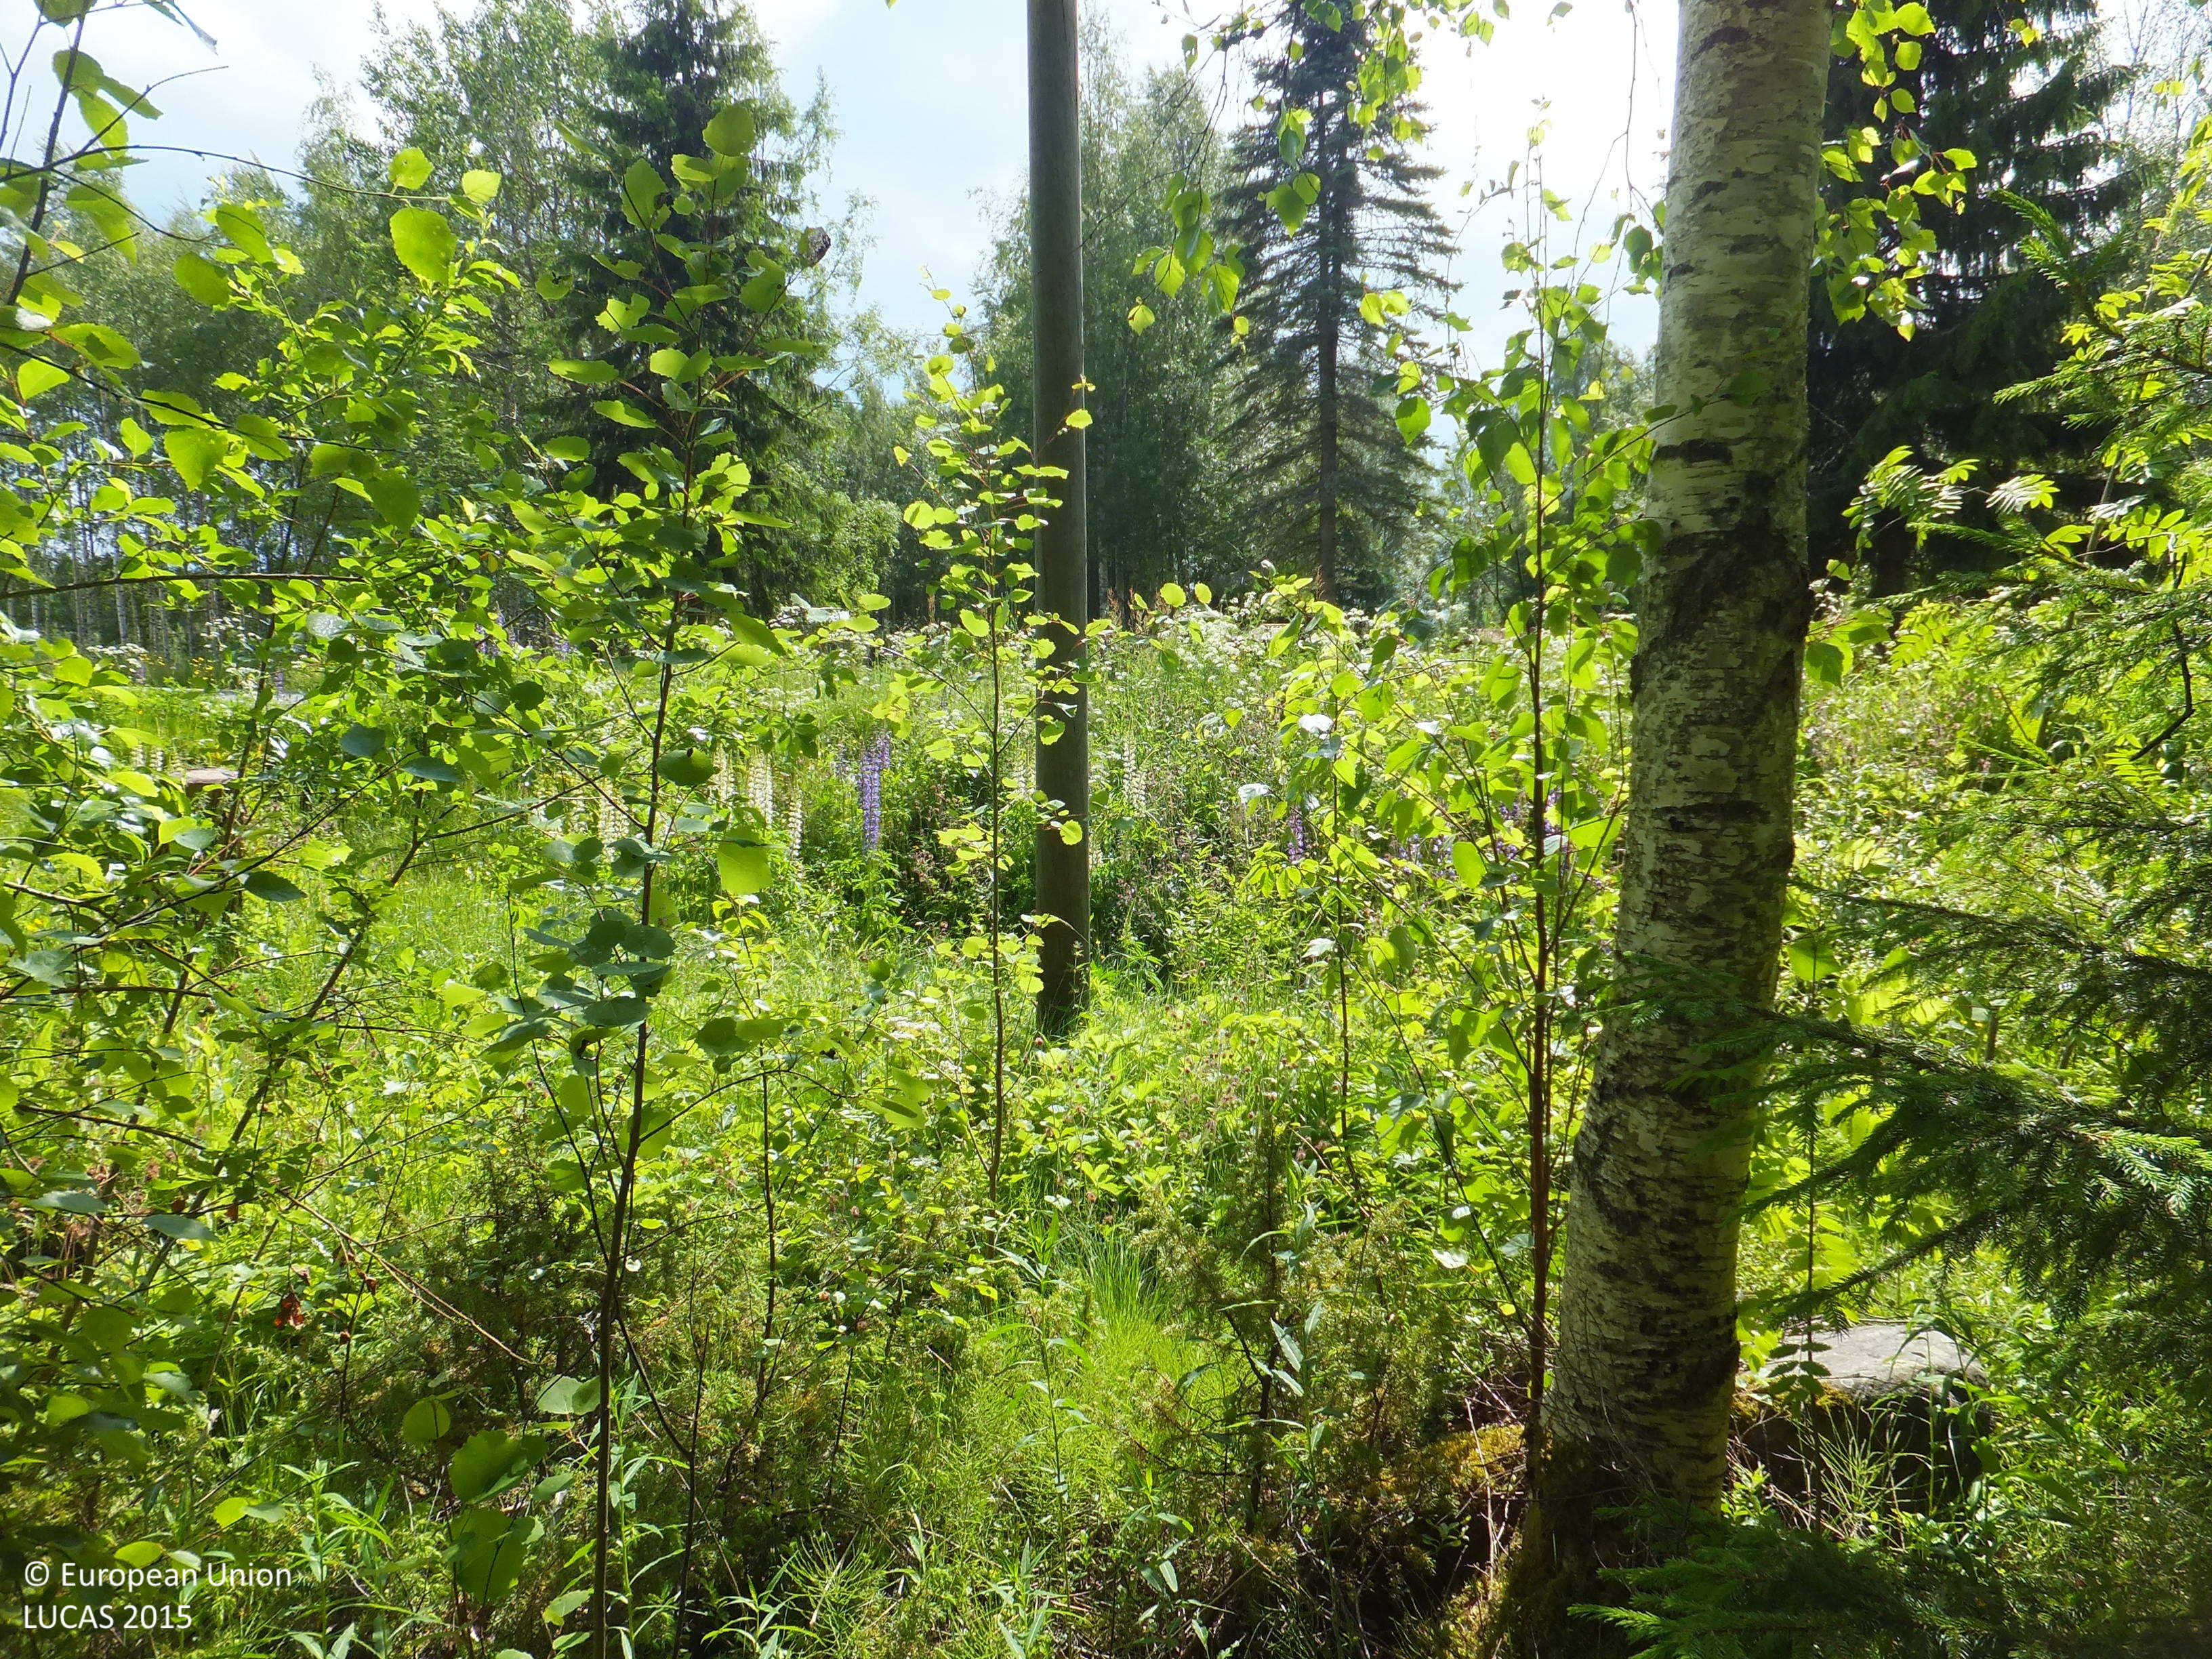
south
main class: Woodland
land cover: Spruce dominated mixed woodland
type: boreal forest
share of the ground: 50 - 75 %
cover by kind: broadleaved forest trees 40 %, herbaceous plants 25 %, coniferous forest trees 20 %, shrubs 15 %
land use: Residential
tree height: > 5 m
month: June
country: FI
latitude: 63.2096
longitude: 23.9329
